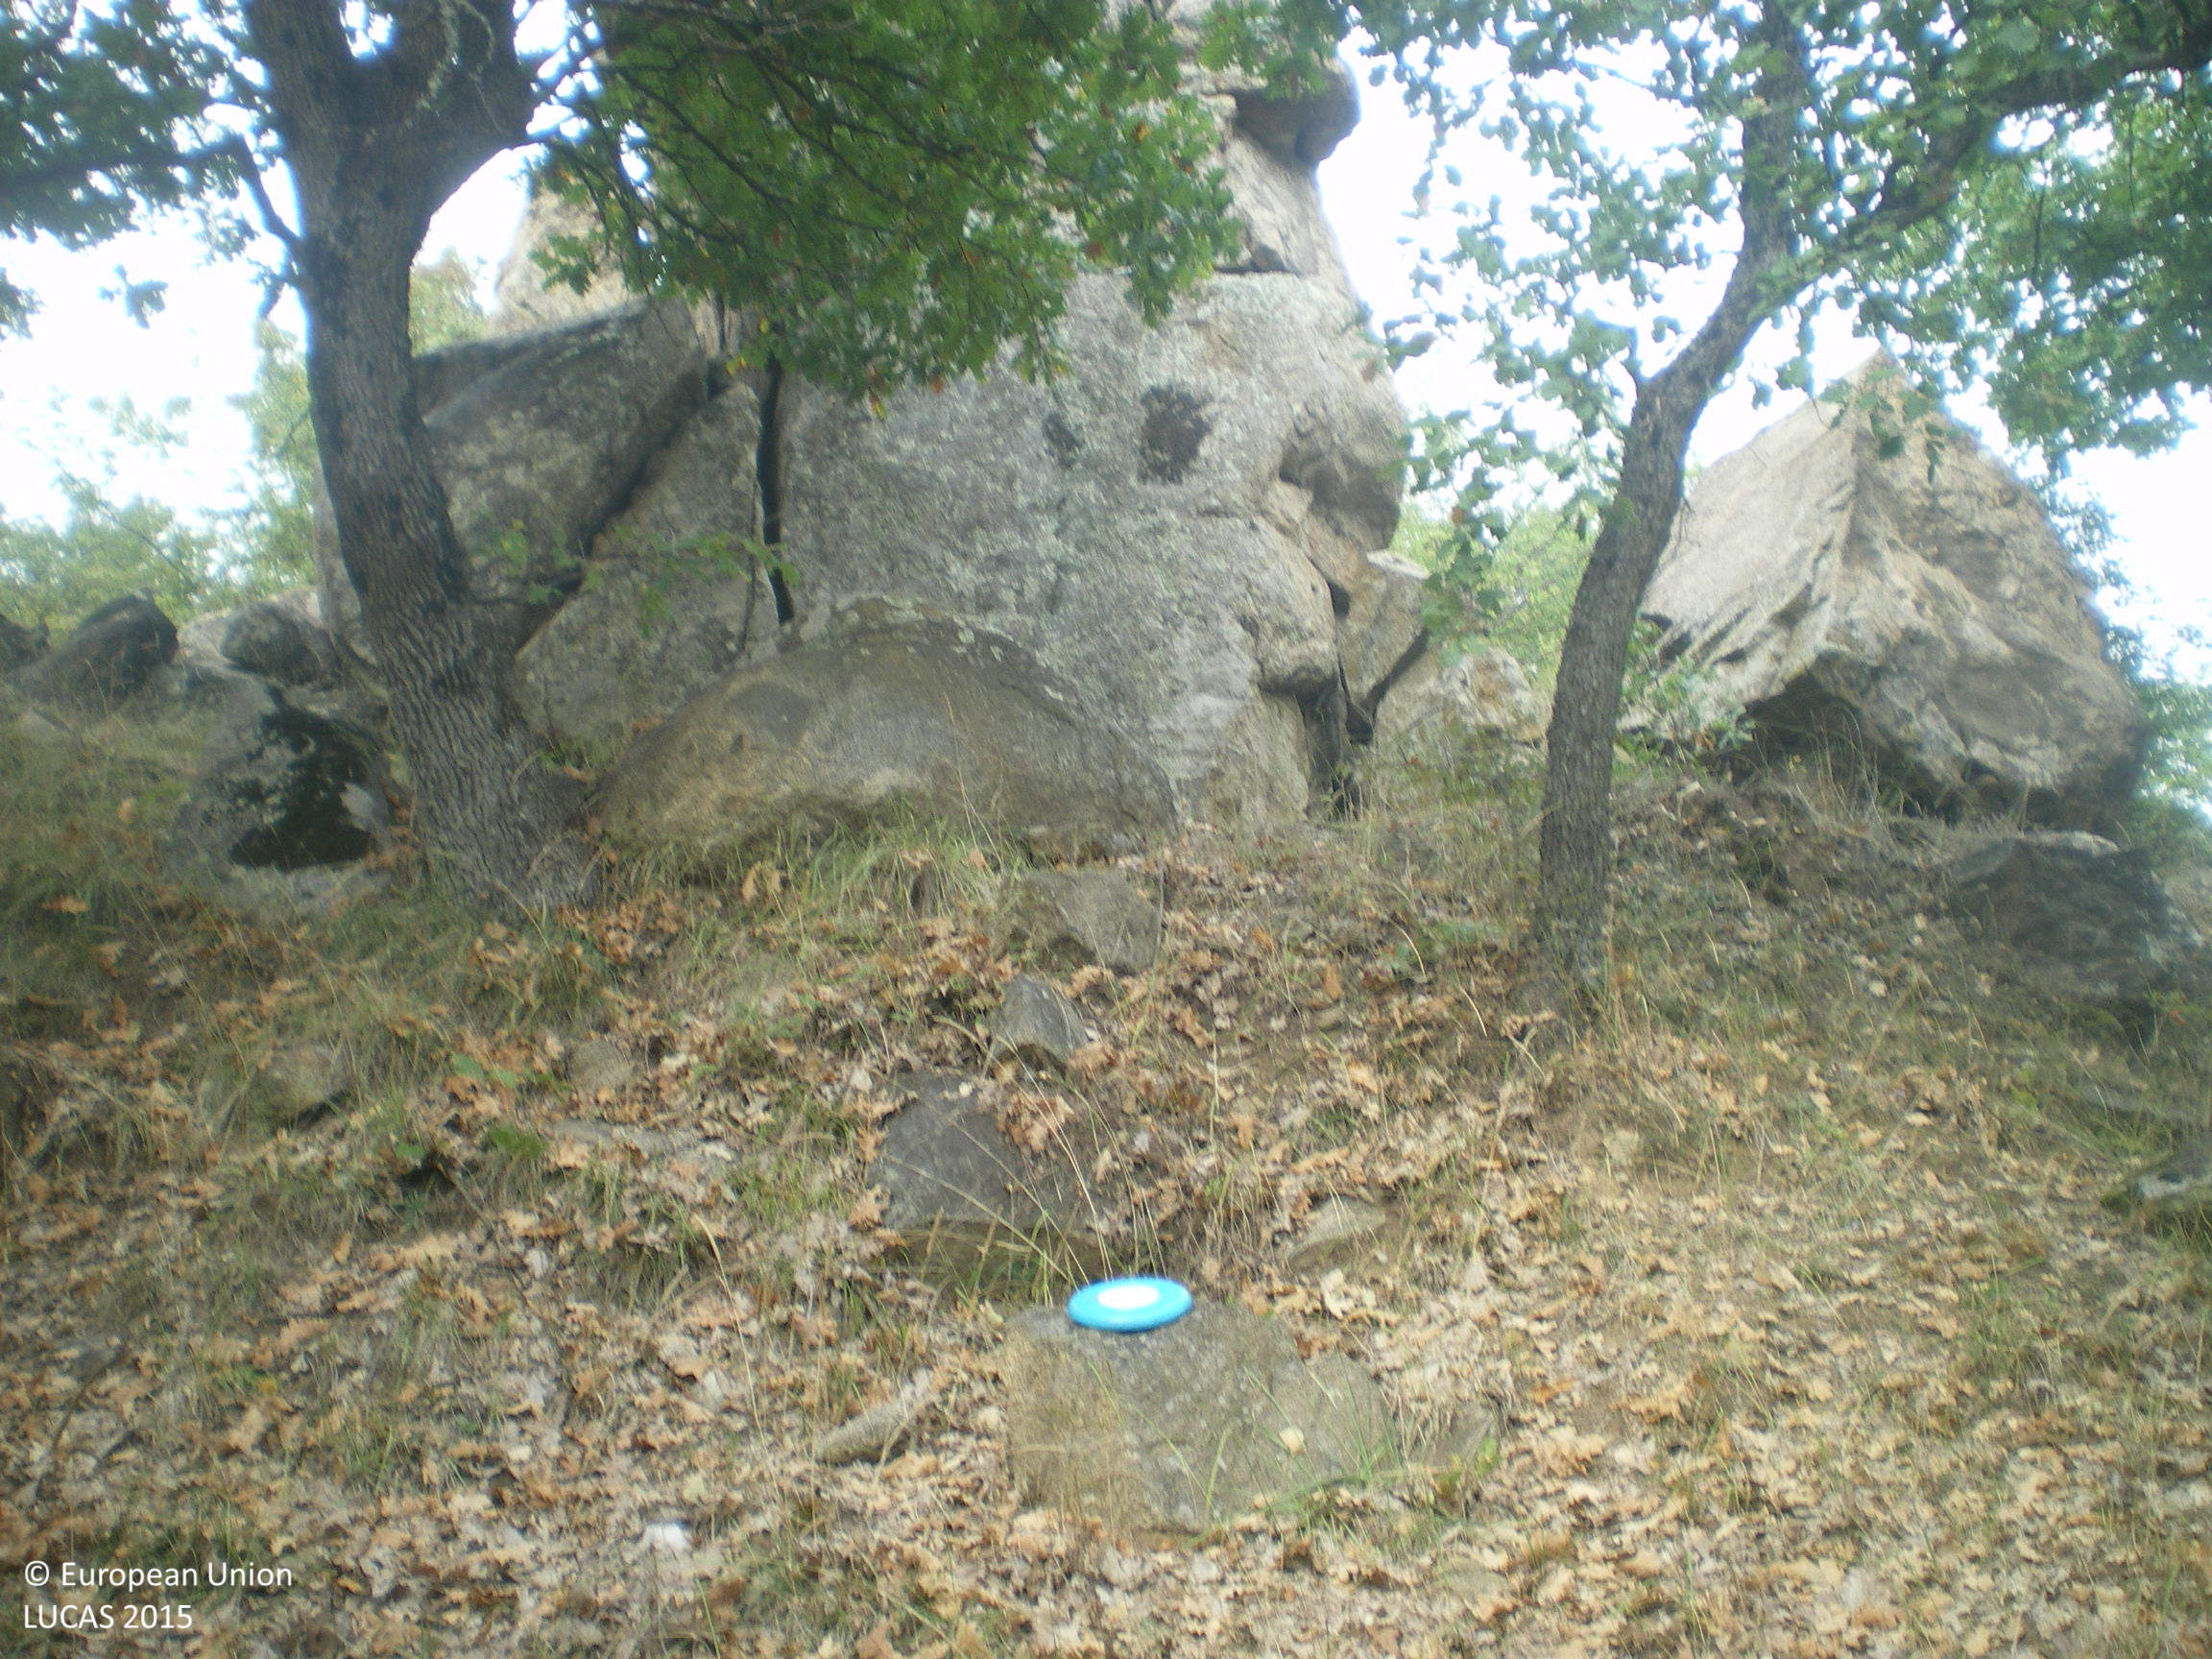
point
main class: Woodland
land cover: Broadleaved woodland
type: mesophytic deciduous forest
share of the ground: > 75 %
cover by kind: broadleaved forest trees 60 %, unconsolidated bare surface 20 %, shrubs 10 %, herbaceous plants 10 %
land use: Forestry
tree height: > 5 m
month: September
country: BG
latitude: 41.8681
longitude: 25.8893
